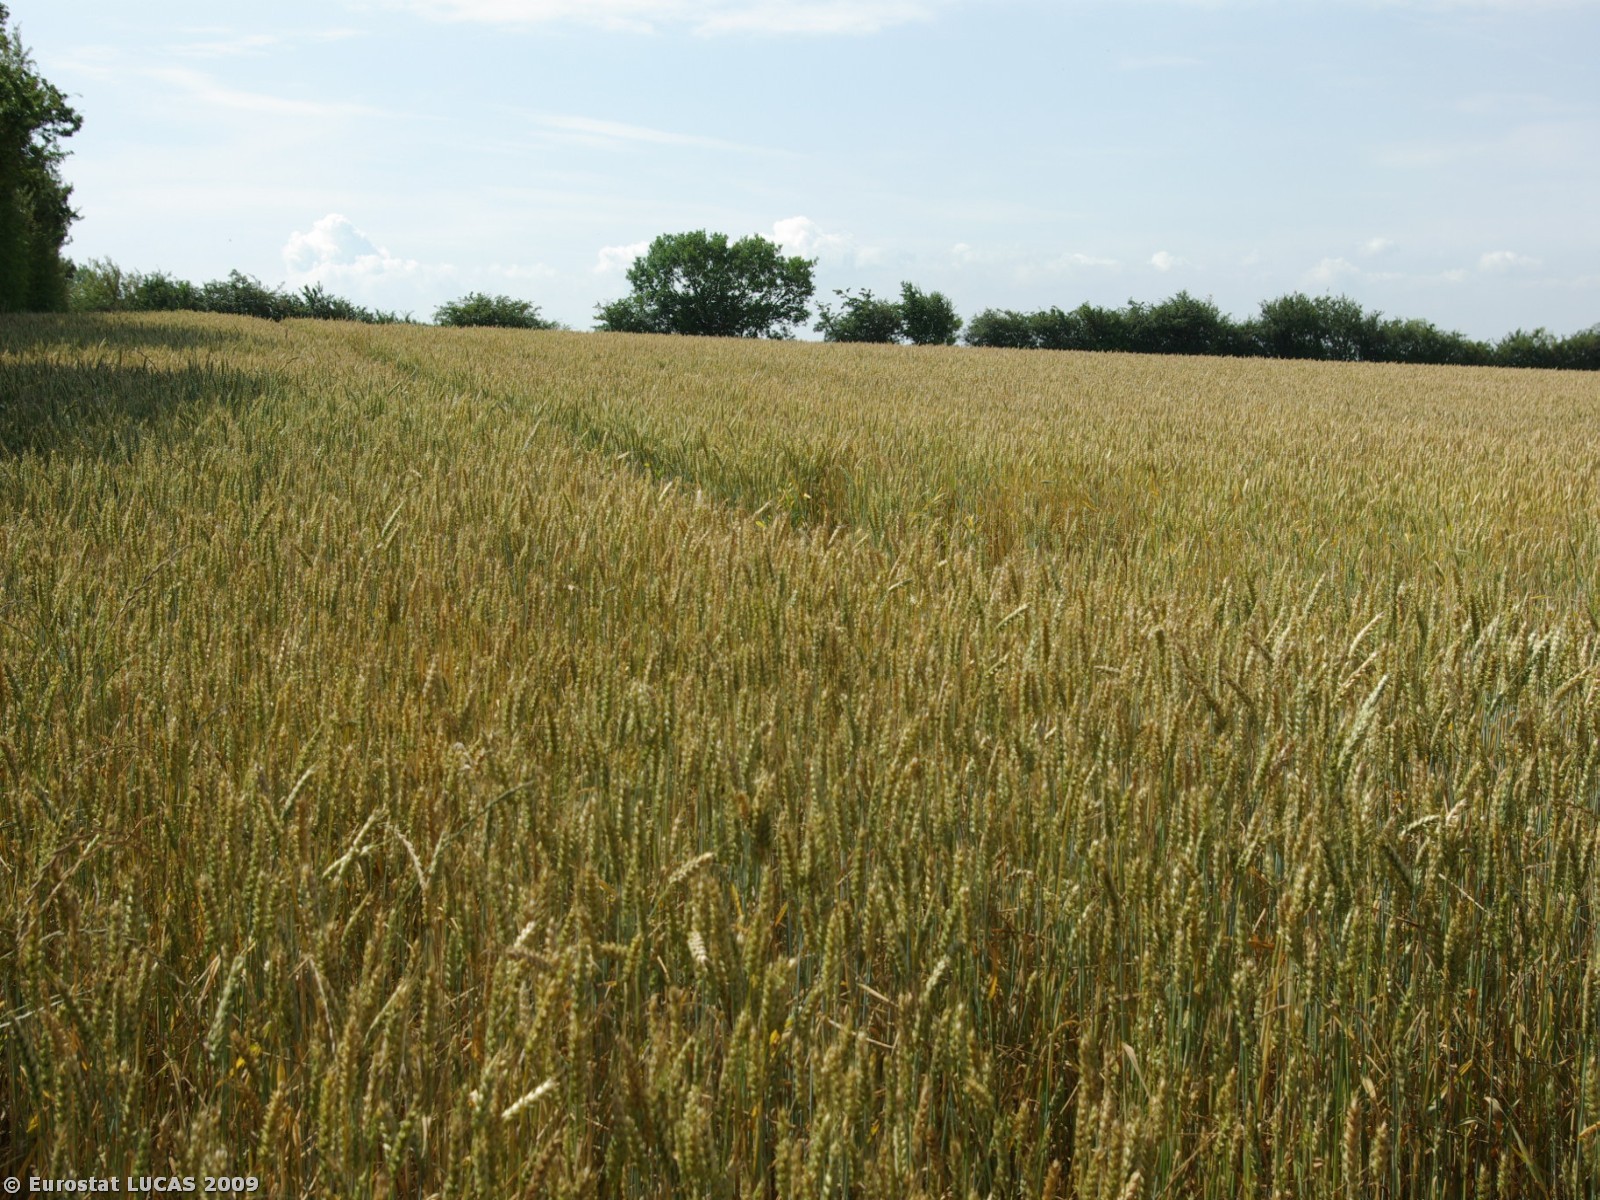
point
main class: Cropland
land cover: Common wheat
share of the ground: > 75 %
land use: Agriculture (excluding fallow land and kitchen gardens)
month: July
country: DK
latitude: 54.8756
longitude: 9.9221
